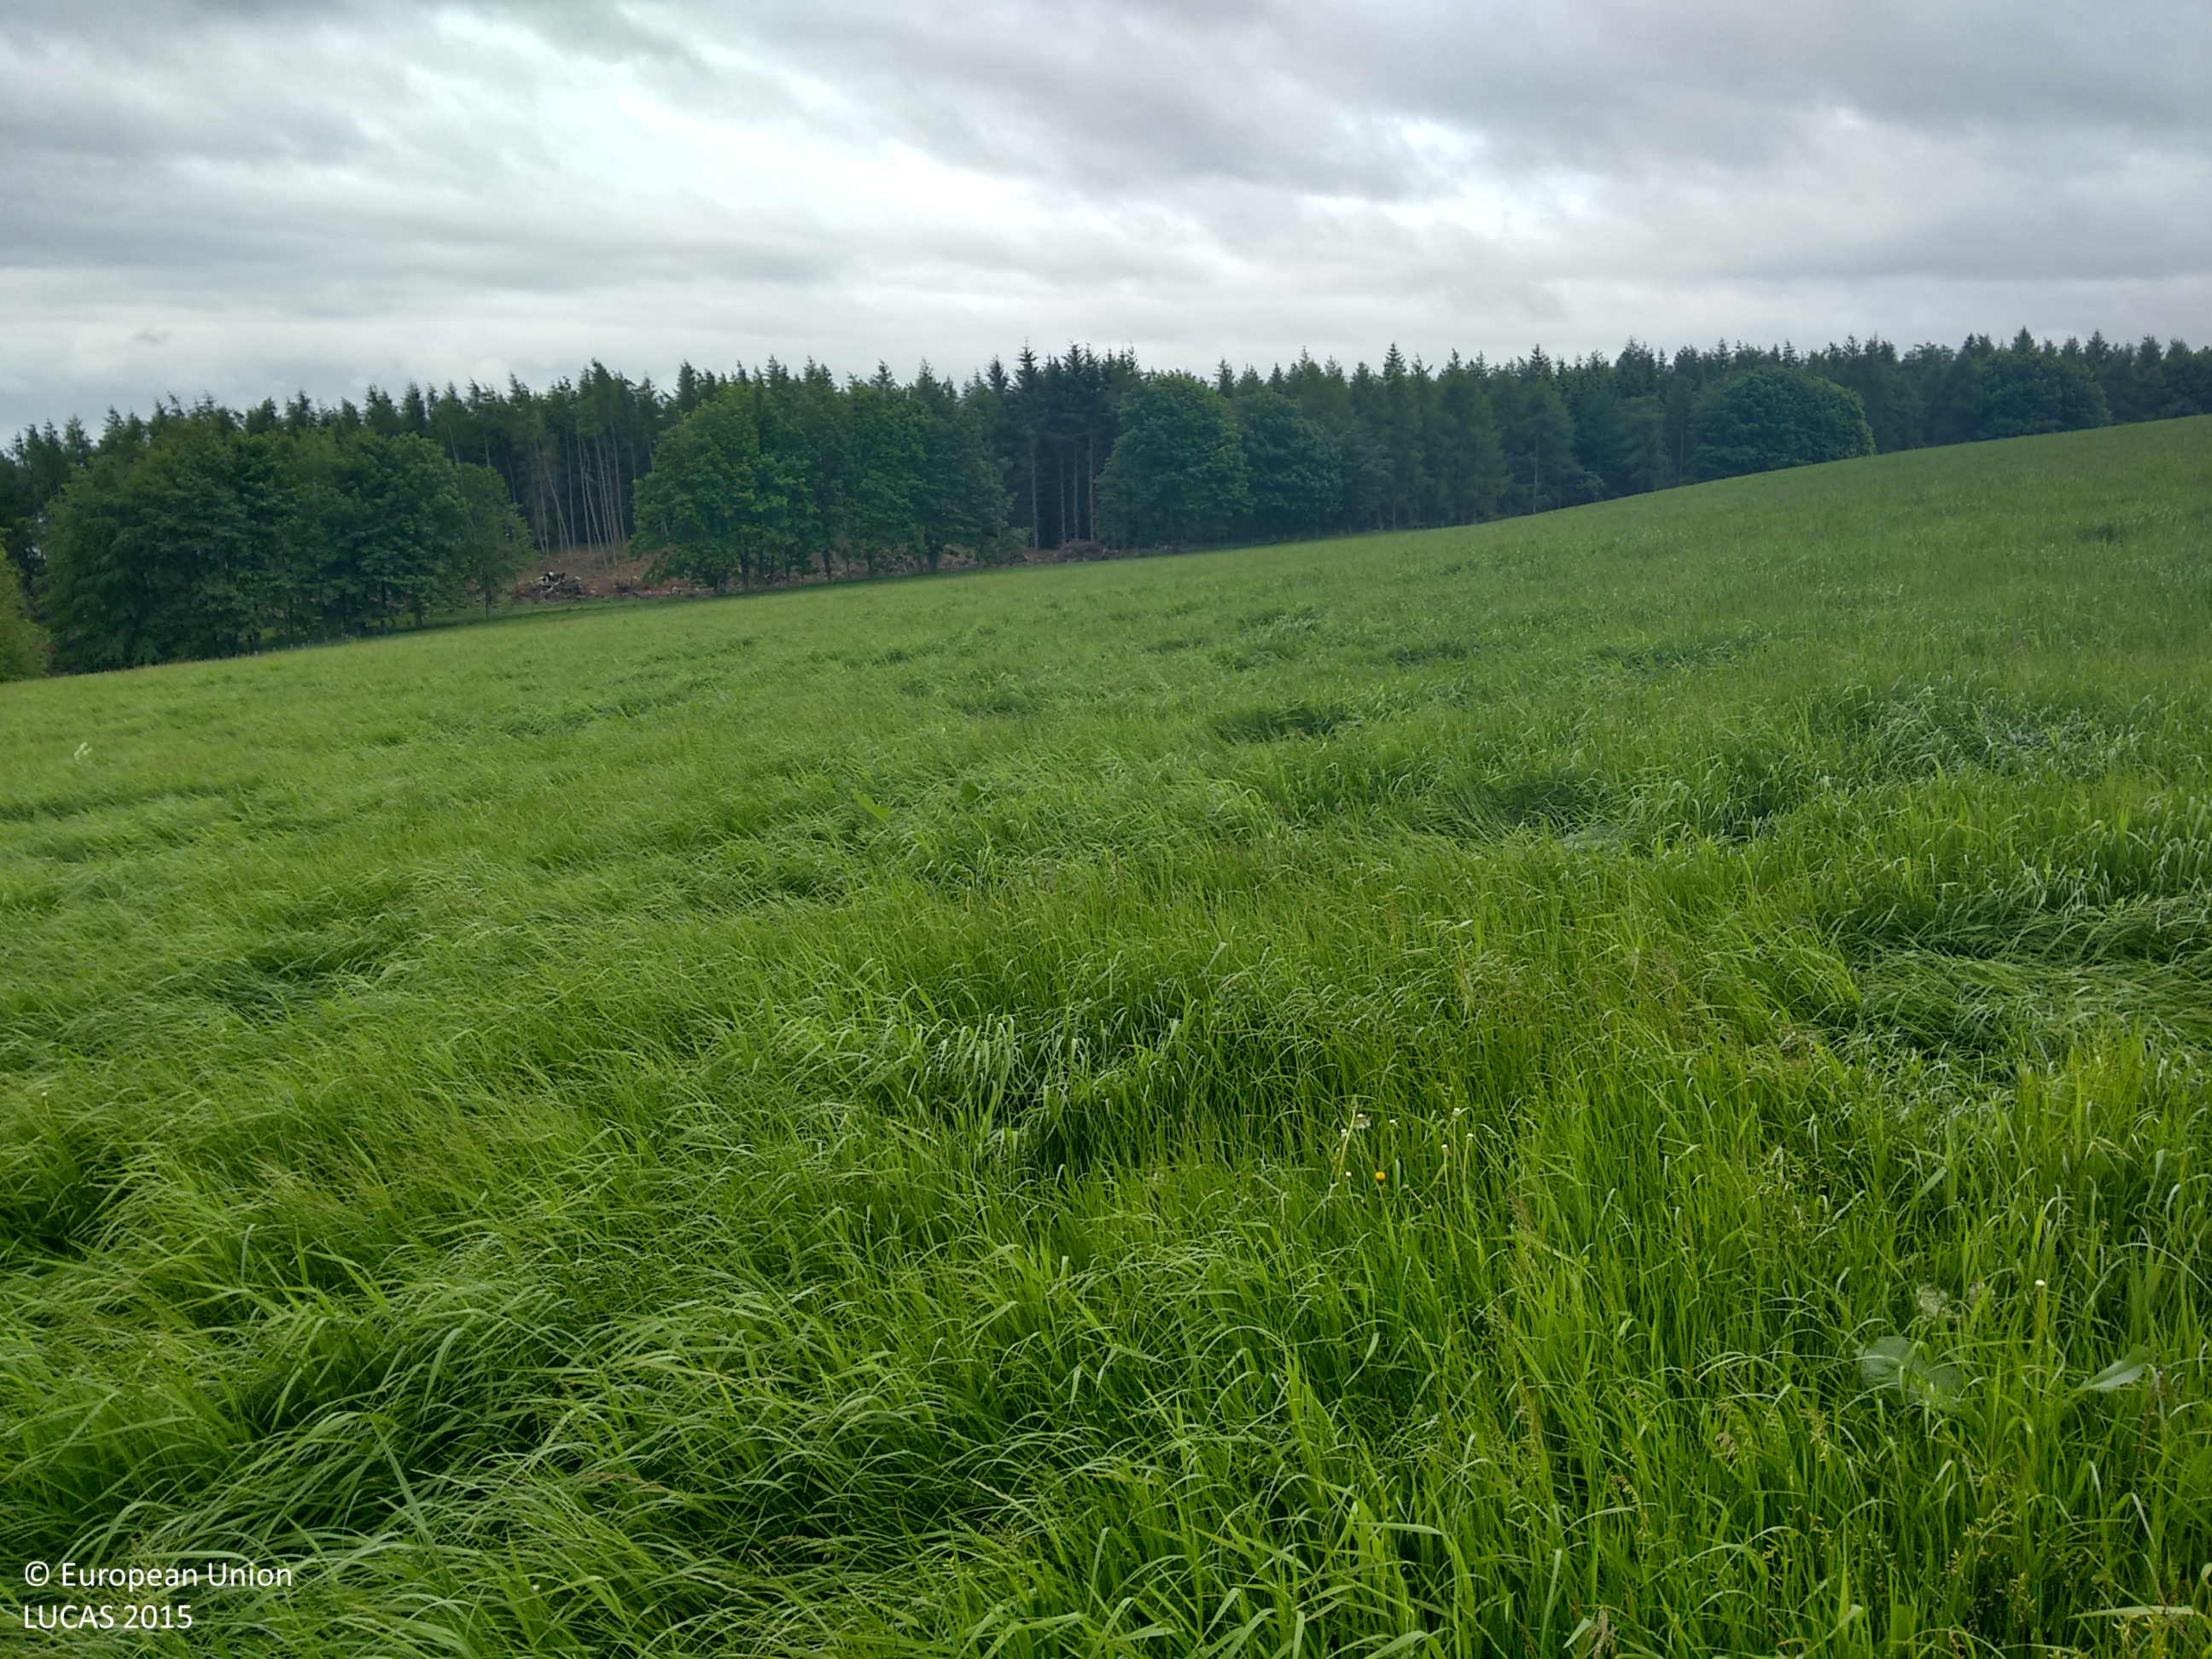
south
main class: Grassland
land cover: Grassland without tree/shrub cover
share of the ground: > 75 %
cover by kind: herbaceous plants 100 %
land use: Agriculture (excluding fallow land and kitchen gardens)
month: June
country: GB
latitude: 56.3996
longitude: -3.3423
